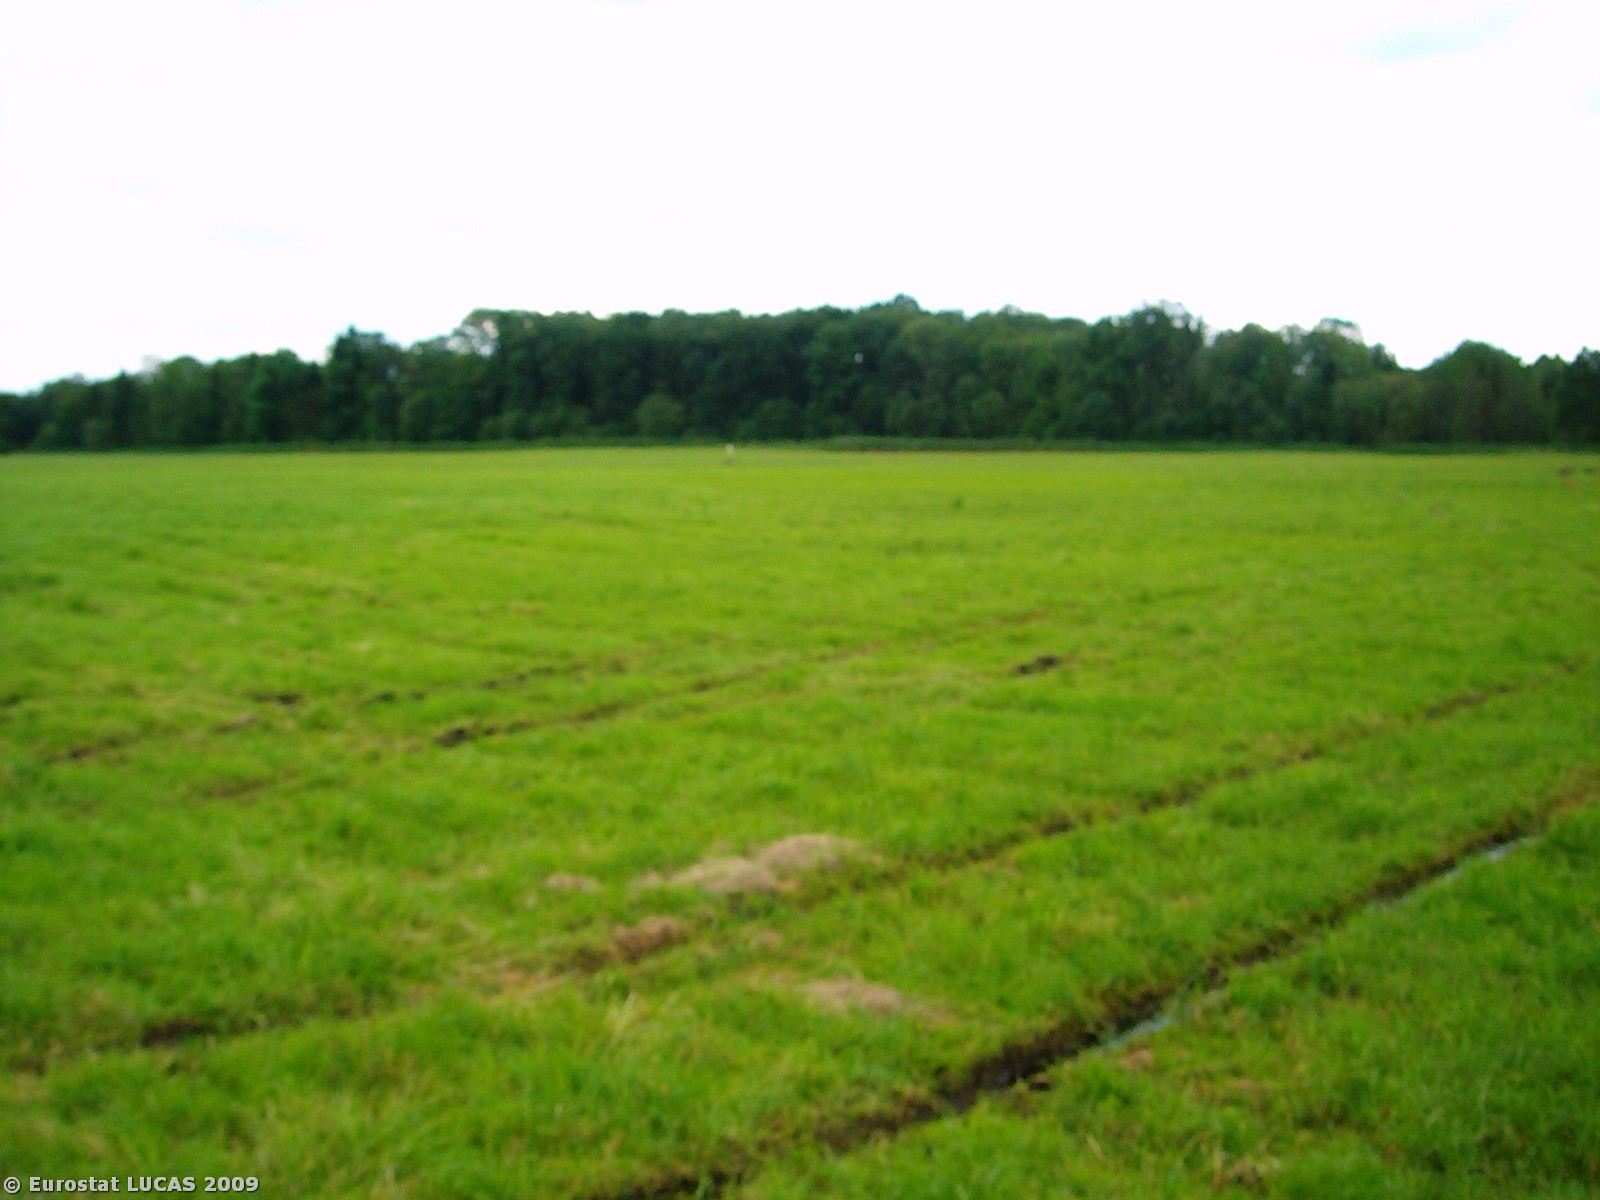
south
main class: Grassland
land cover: Grassland without tree/shrub cover
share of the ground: > 75 %
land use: Agriculture (excluding fallow land and kitchen gardens)
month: July
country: PL
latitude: 52.2942
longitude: 15.7083
